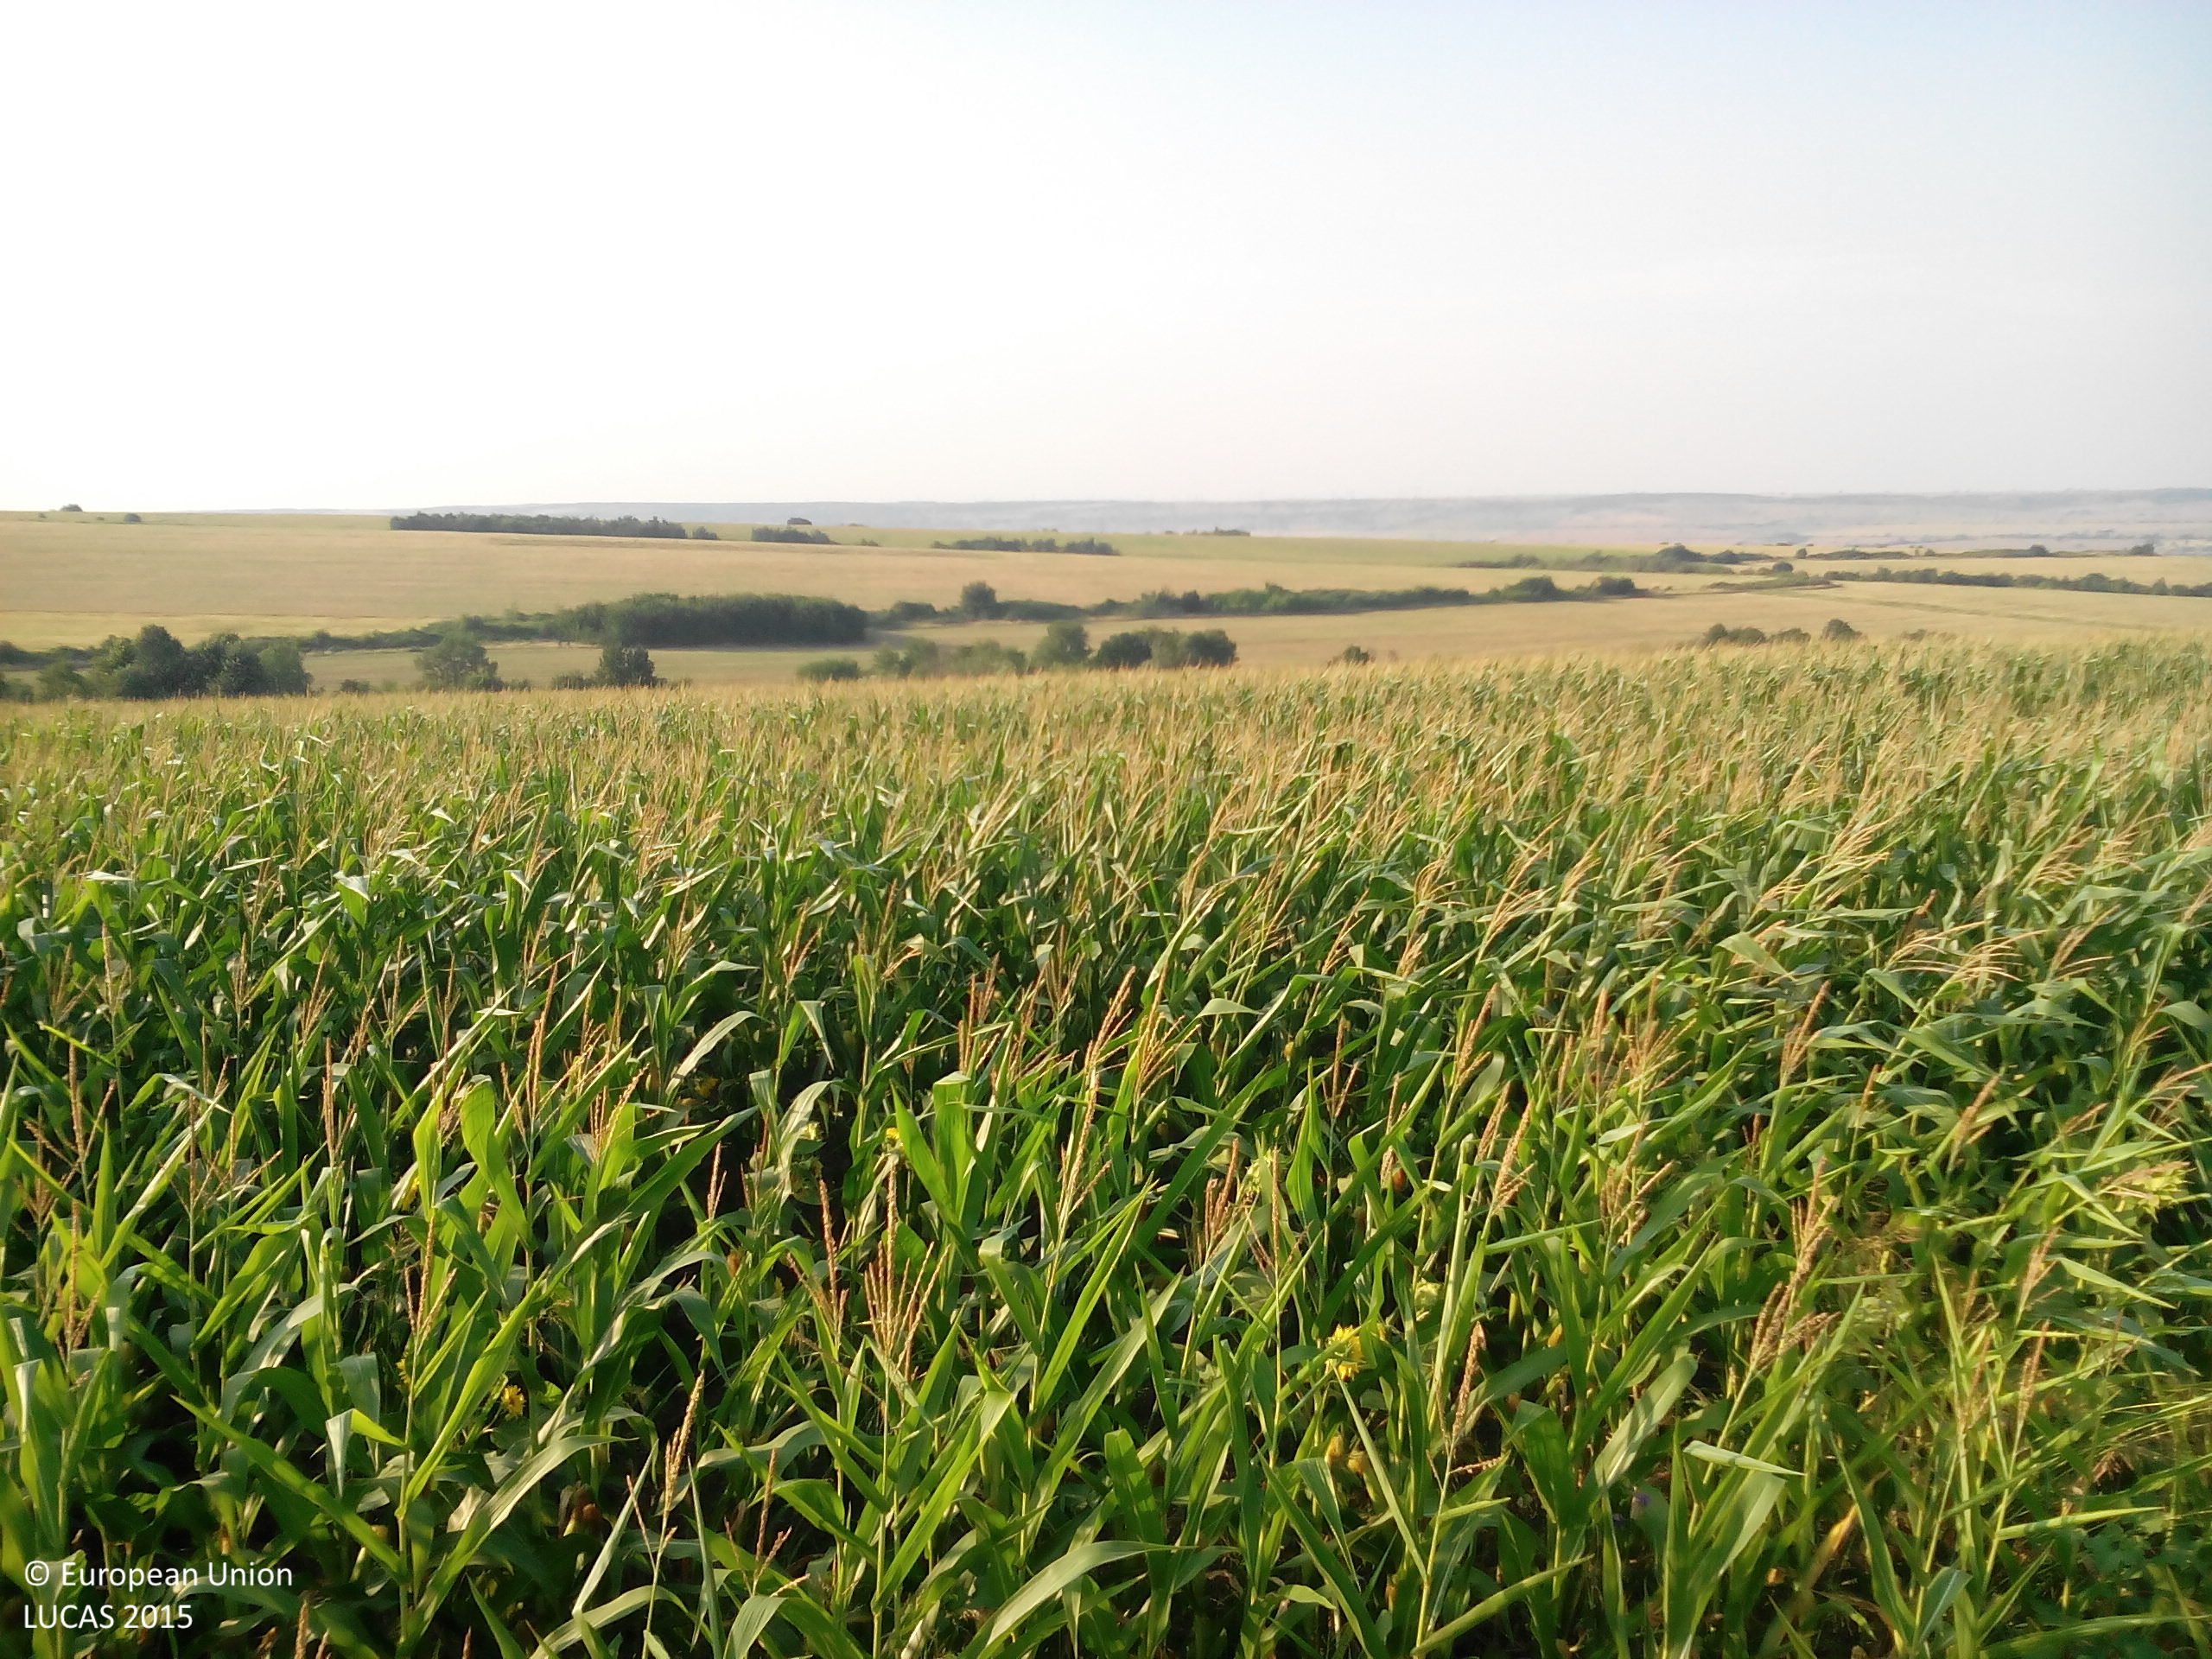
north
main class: Cropland
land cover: Sunflower
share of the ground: > 75 %
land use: Agriculture (excluding fallow land and kitchen gardens)
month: July
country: BG
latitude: 43.2288
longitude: 24.1505
